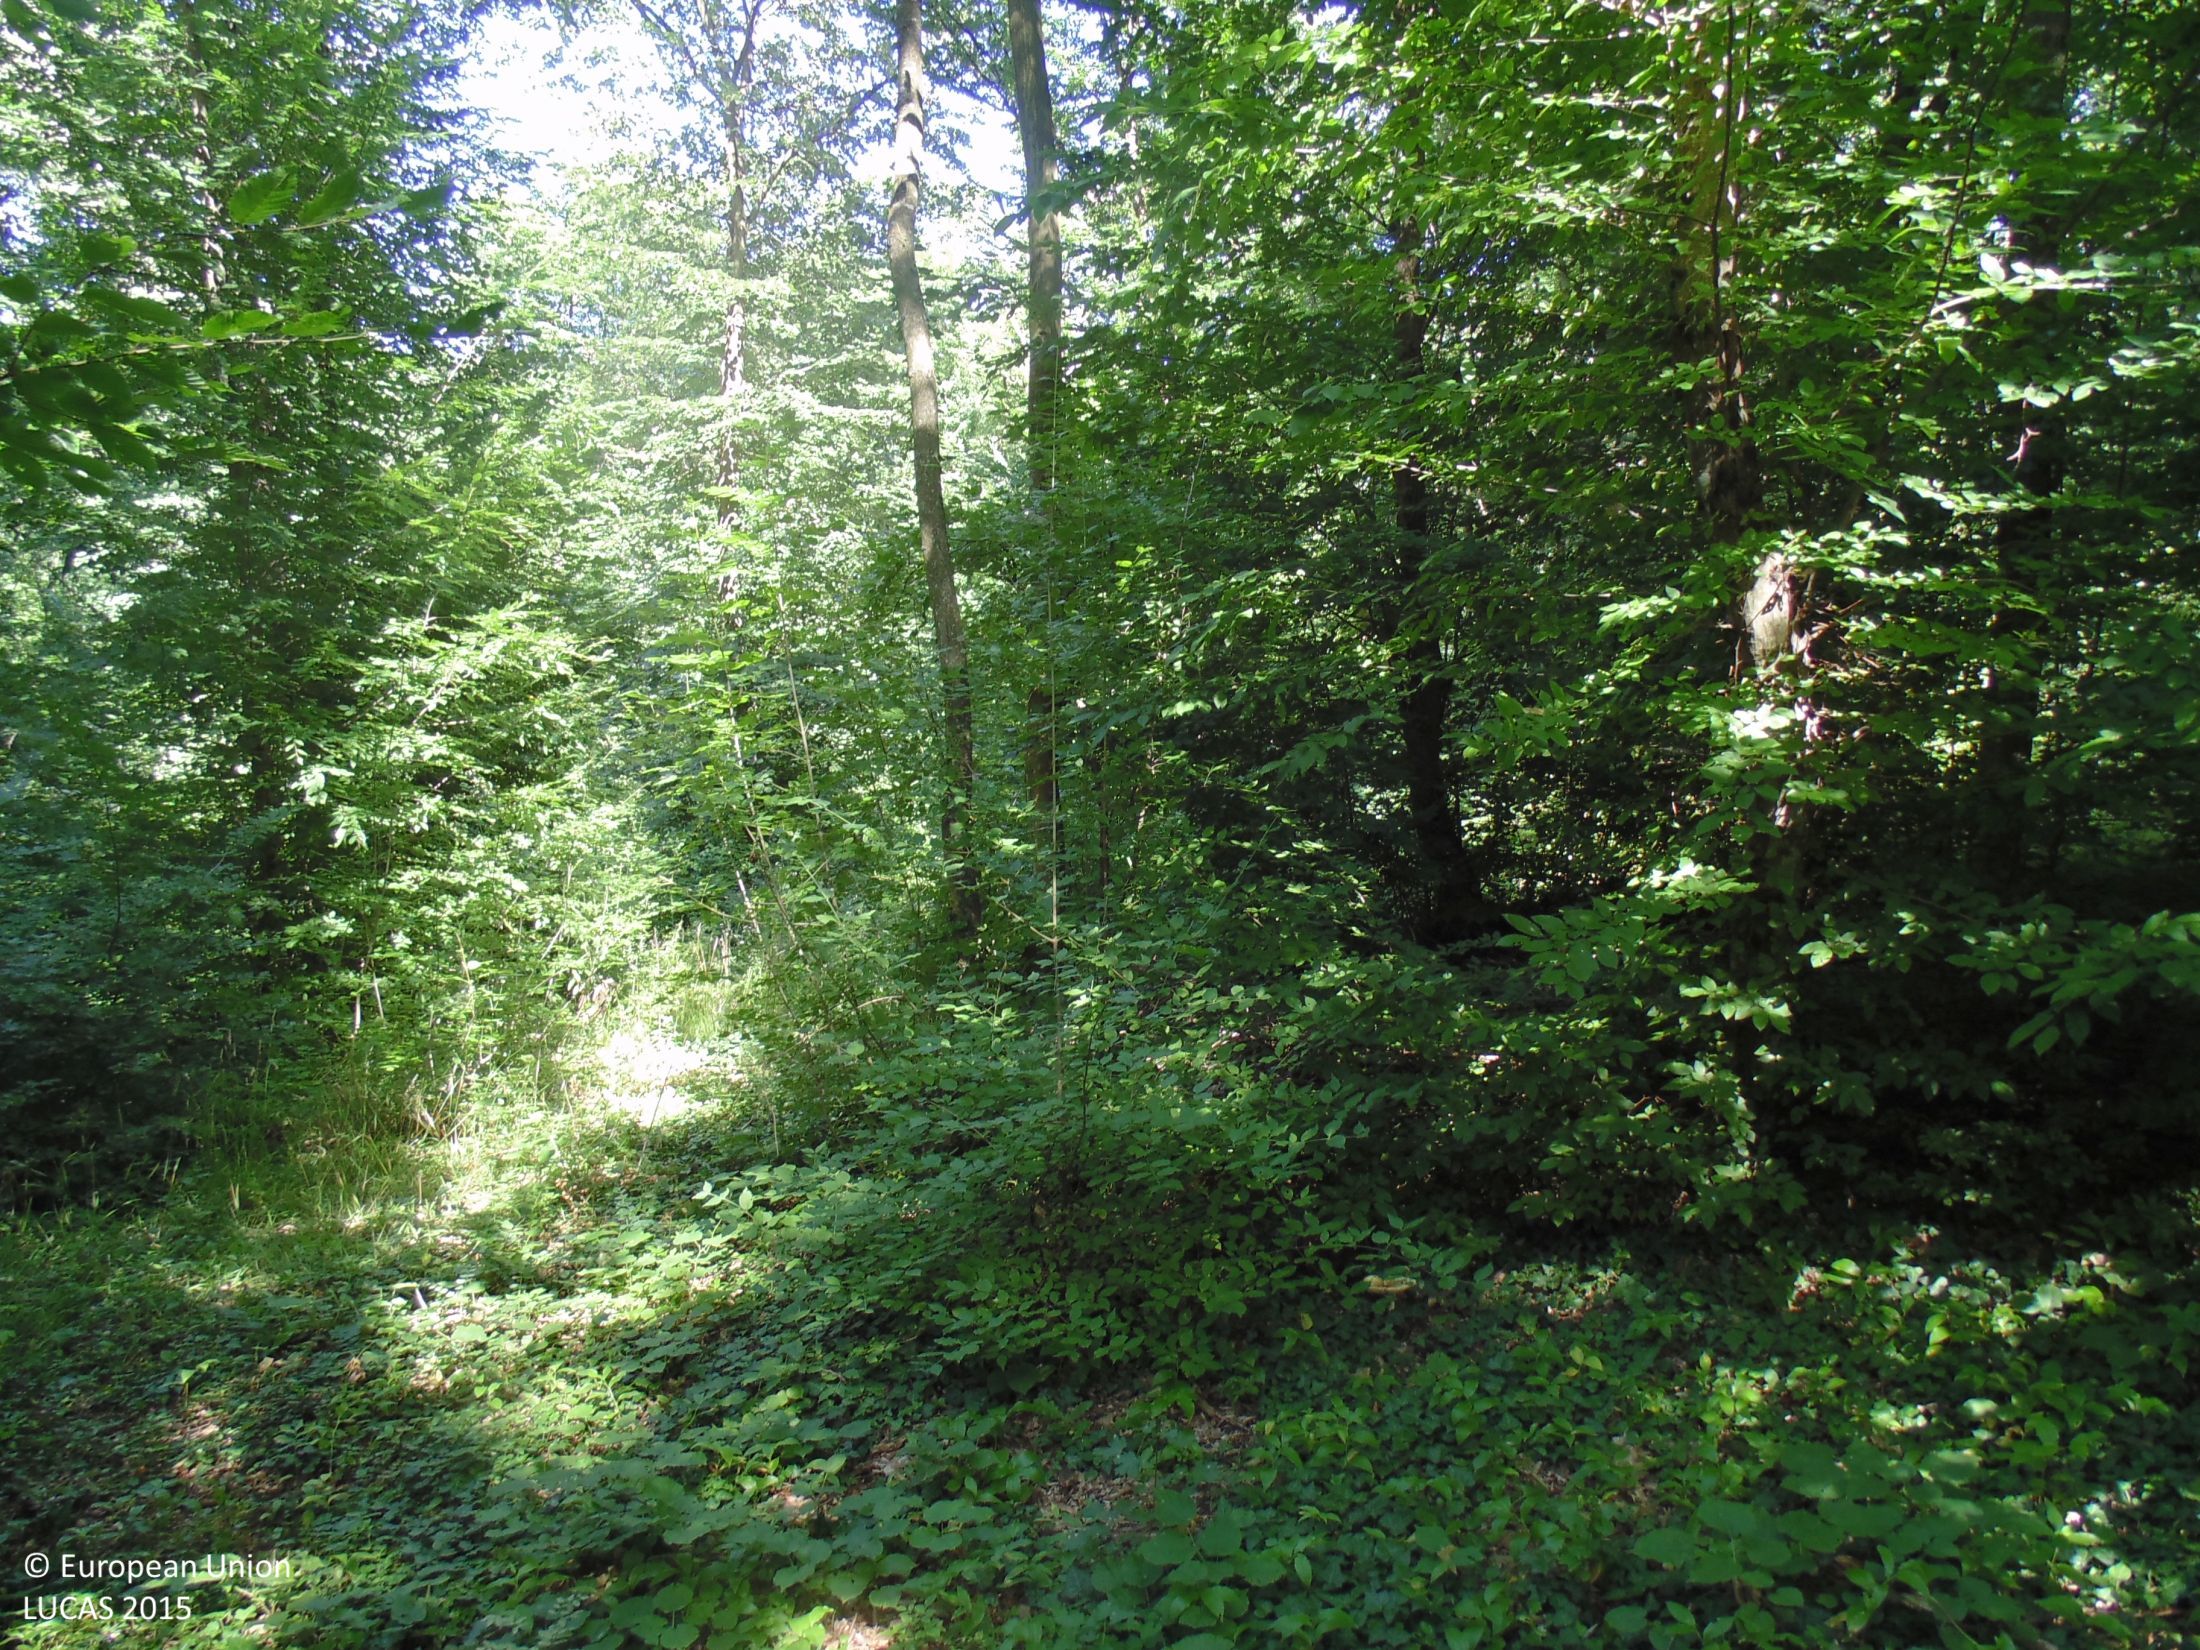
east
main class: Woodland
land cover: Broadleaved woodland
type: mesophytic deciduous forest
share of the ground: > 75 %
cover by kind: broadleaved forest trees 90 %, shrubs 10 %
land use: Forestry
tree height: > 5 m
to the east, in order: Broadleaved woodland
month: July
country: BG
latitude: 43.3908
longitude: 27.9825
